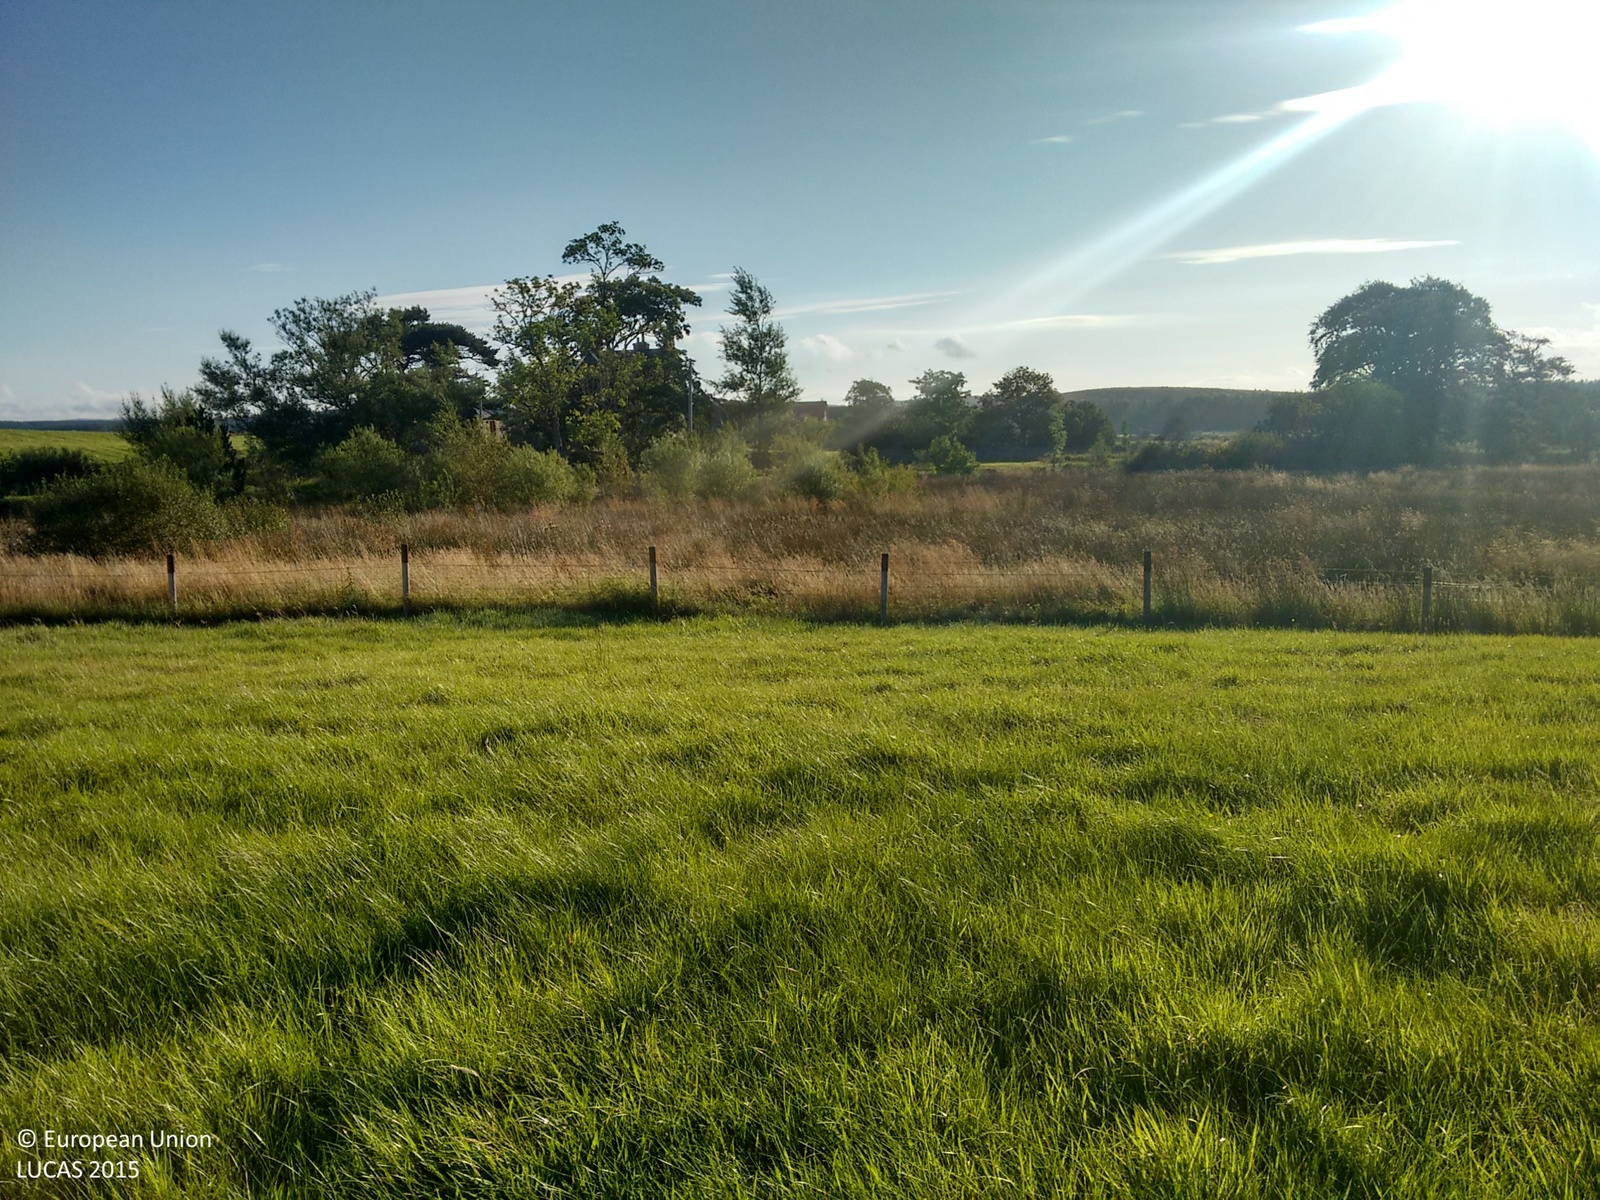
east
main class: Grassland
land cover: Grassland without tree/shrub cover
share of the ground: > 75 %
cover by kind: herbaceous plants 100 %
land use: Residential
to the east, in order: Grassland without tree/shrub cover; Fences; Grassland without tree/shrub cover; Grassland with sparse tree/shrub cover; Managed hedges; Grass margins; Paved roads, cycling and walking lanes; Grass margins; Ditches and canals; Grassland without tree/shrub cover; Dry stone walls; Lines of trees; Grassland without tree/shrub cover; Fences; Grassland without tree/shrub cover; Fences; Tracks; Fences; Grassland without tree/shrub cover
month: September
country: GB
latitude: 58.0567
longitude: -4.4398
